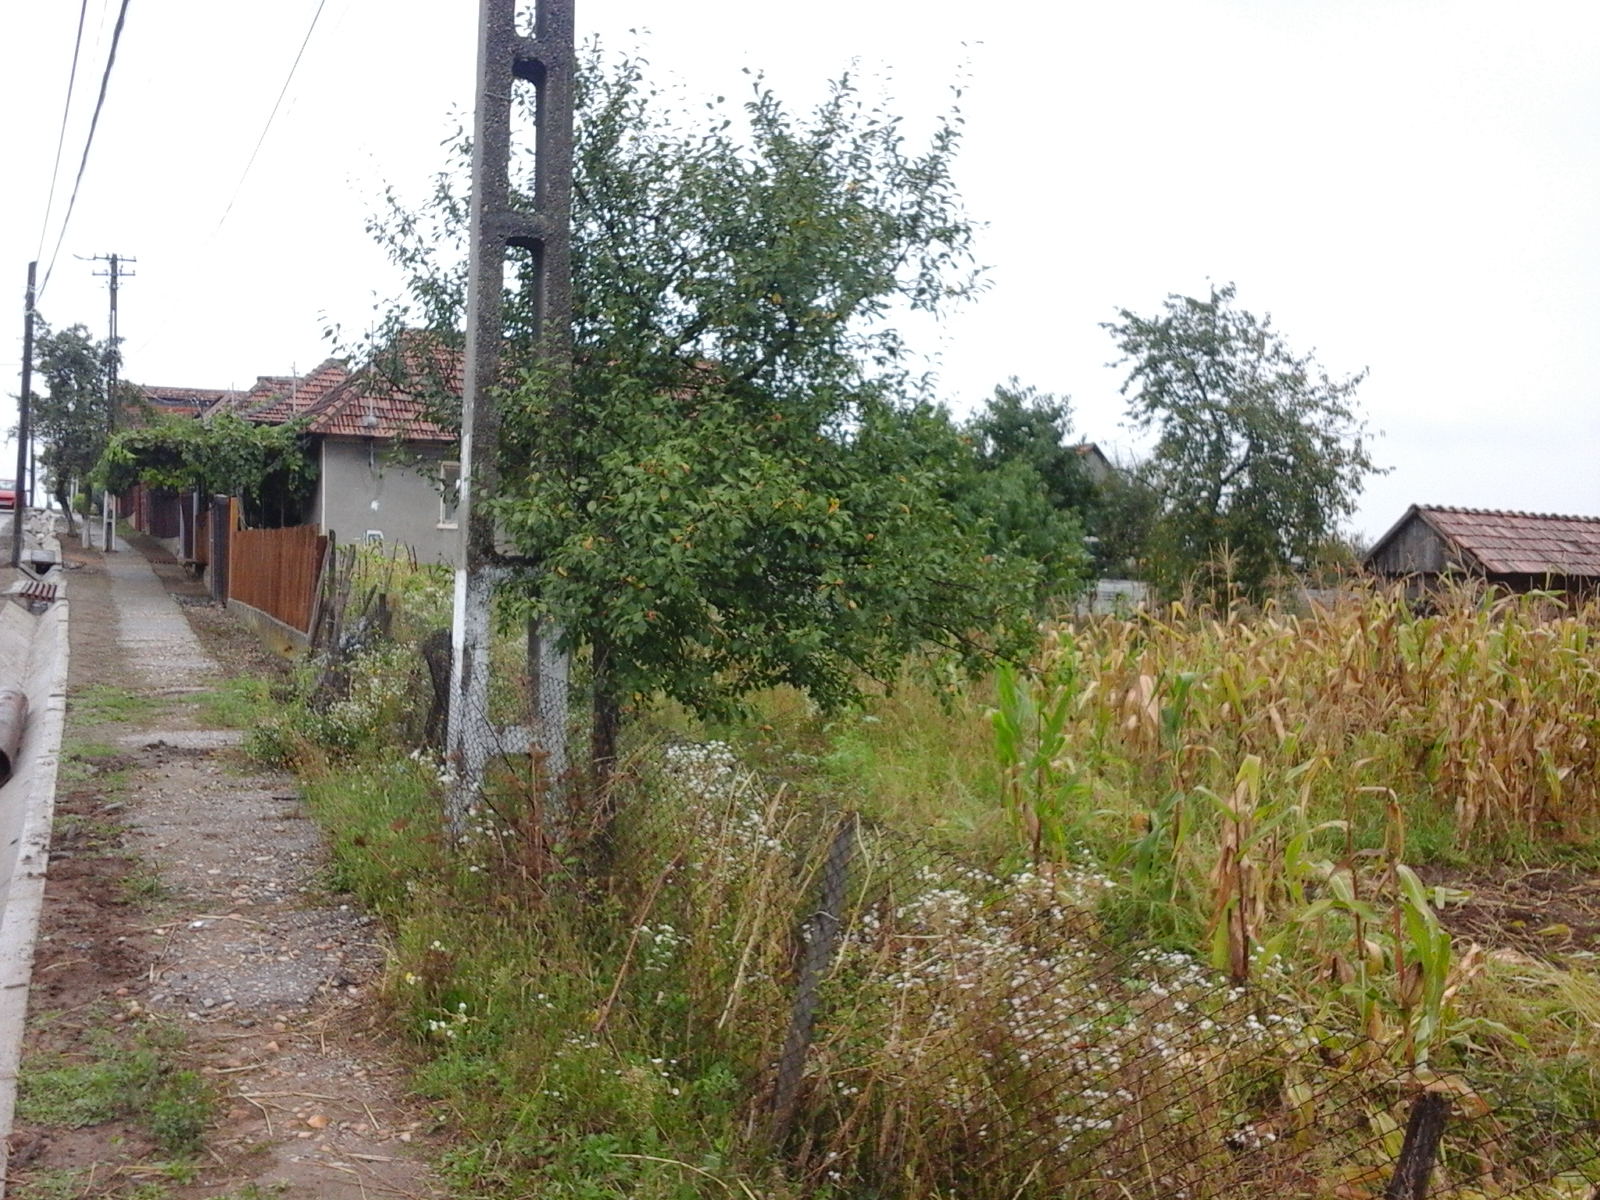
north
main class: Cropland
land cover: Maize
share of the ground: > 75 %
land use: Agriculture (excluding fallow land and kitchen gardens)
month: September
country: RO
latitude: 47.2105
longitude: 22.5596
